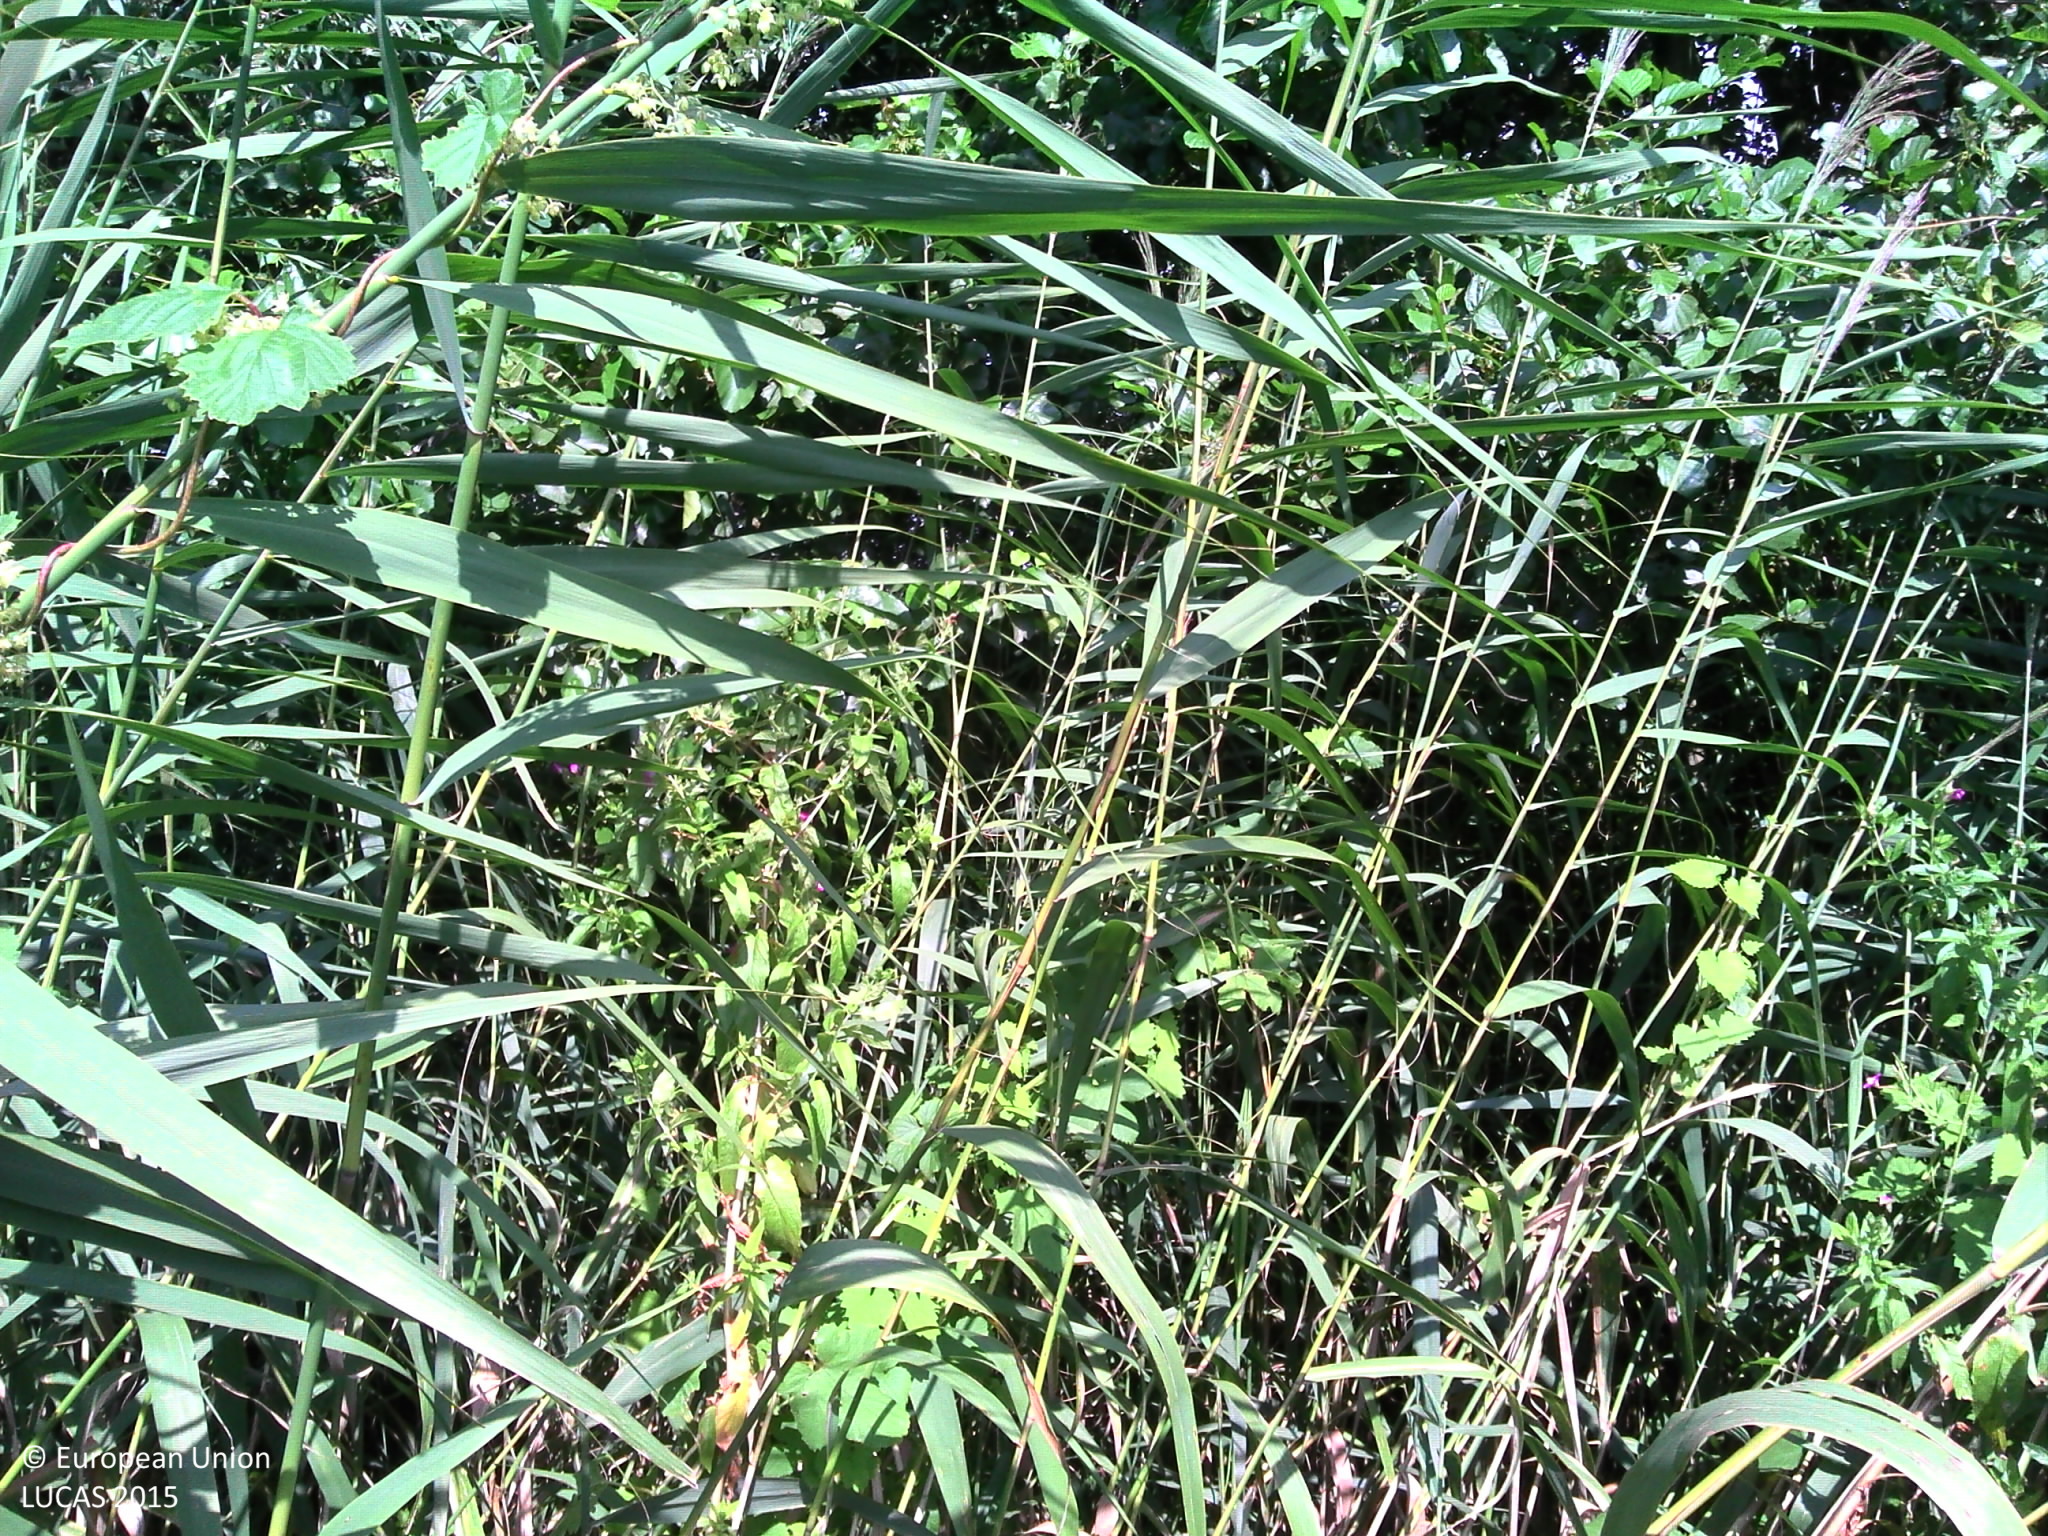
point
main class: Woodland
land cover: Broadleaved woodland
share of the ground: > 75 %
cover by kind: broadleaved forest trees 90 %, herbaceous plants 10 %
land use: Forestry
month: August
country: BE
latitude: 51.2336
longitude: 5.1423
